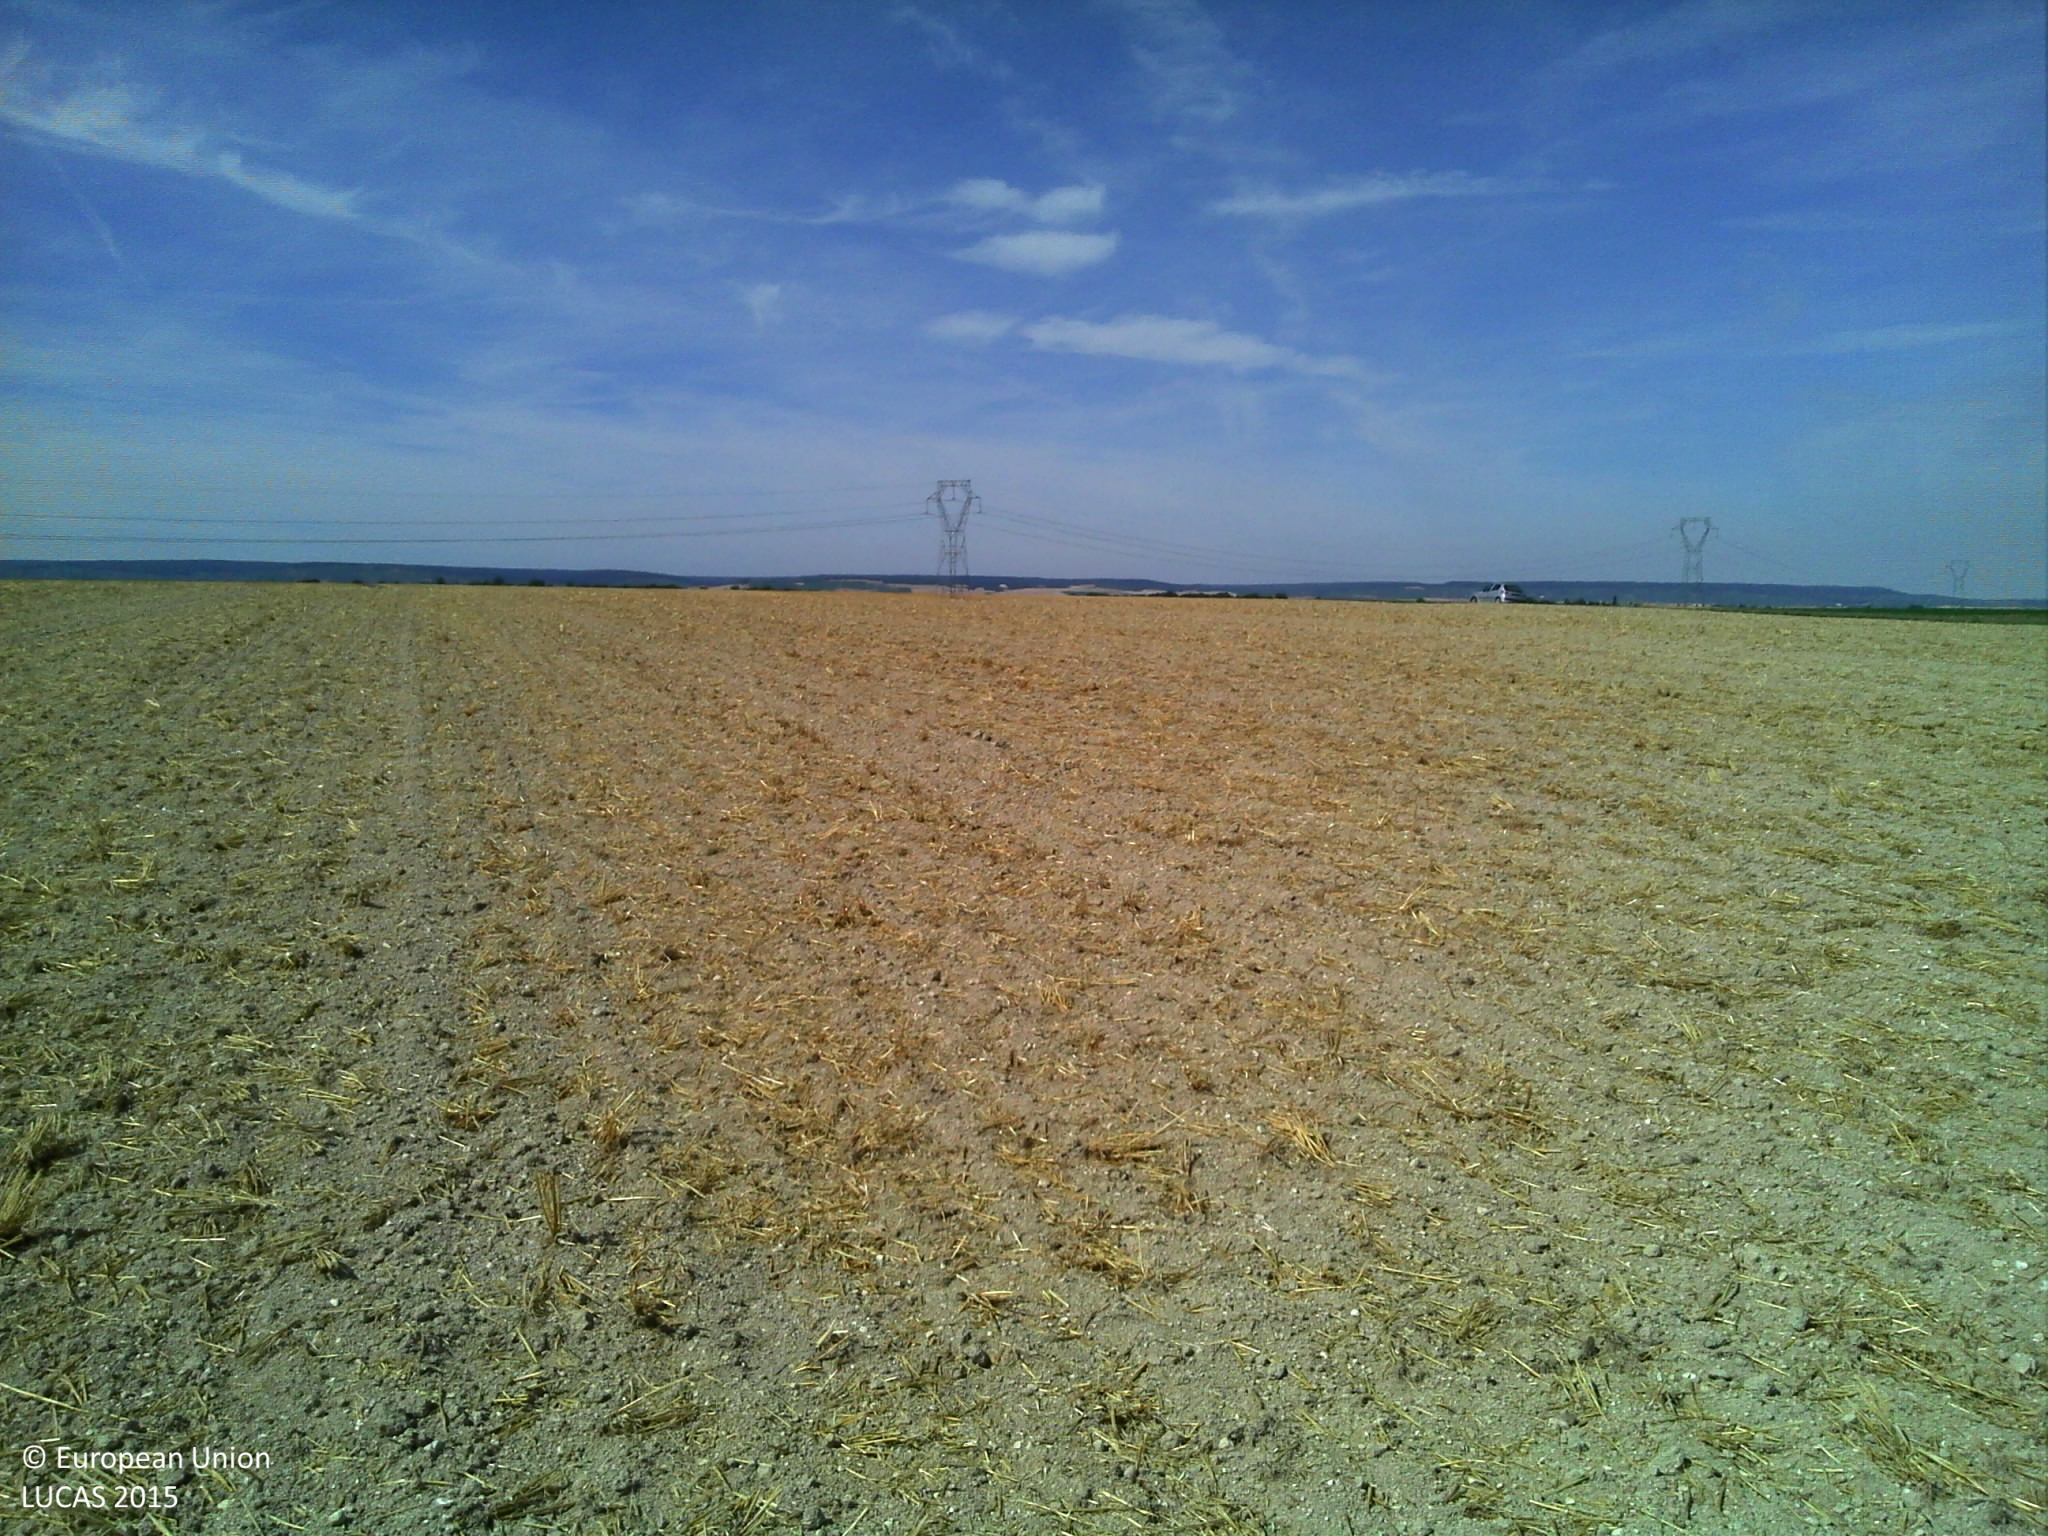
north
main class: Cropland
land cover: Common wheat
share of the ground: > 75 %
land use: Agriculture (excluding fallow land and kitchen gardens)
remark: Tilled/Sowed
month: August
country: FR
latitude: 48.9500
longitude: 4.1102
